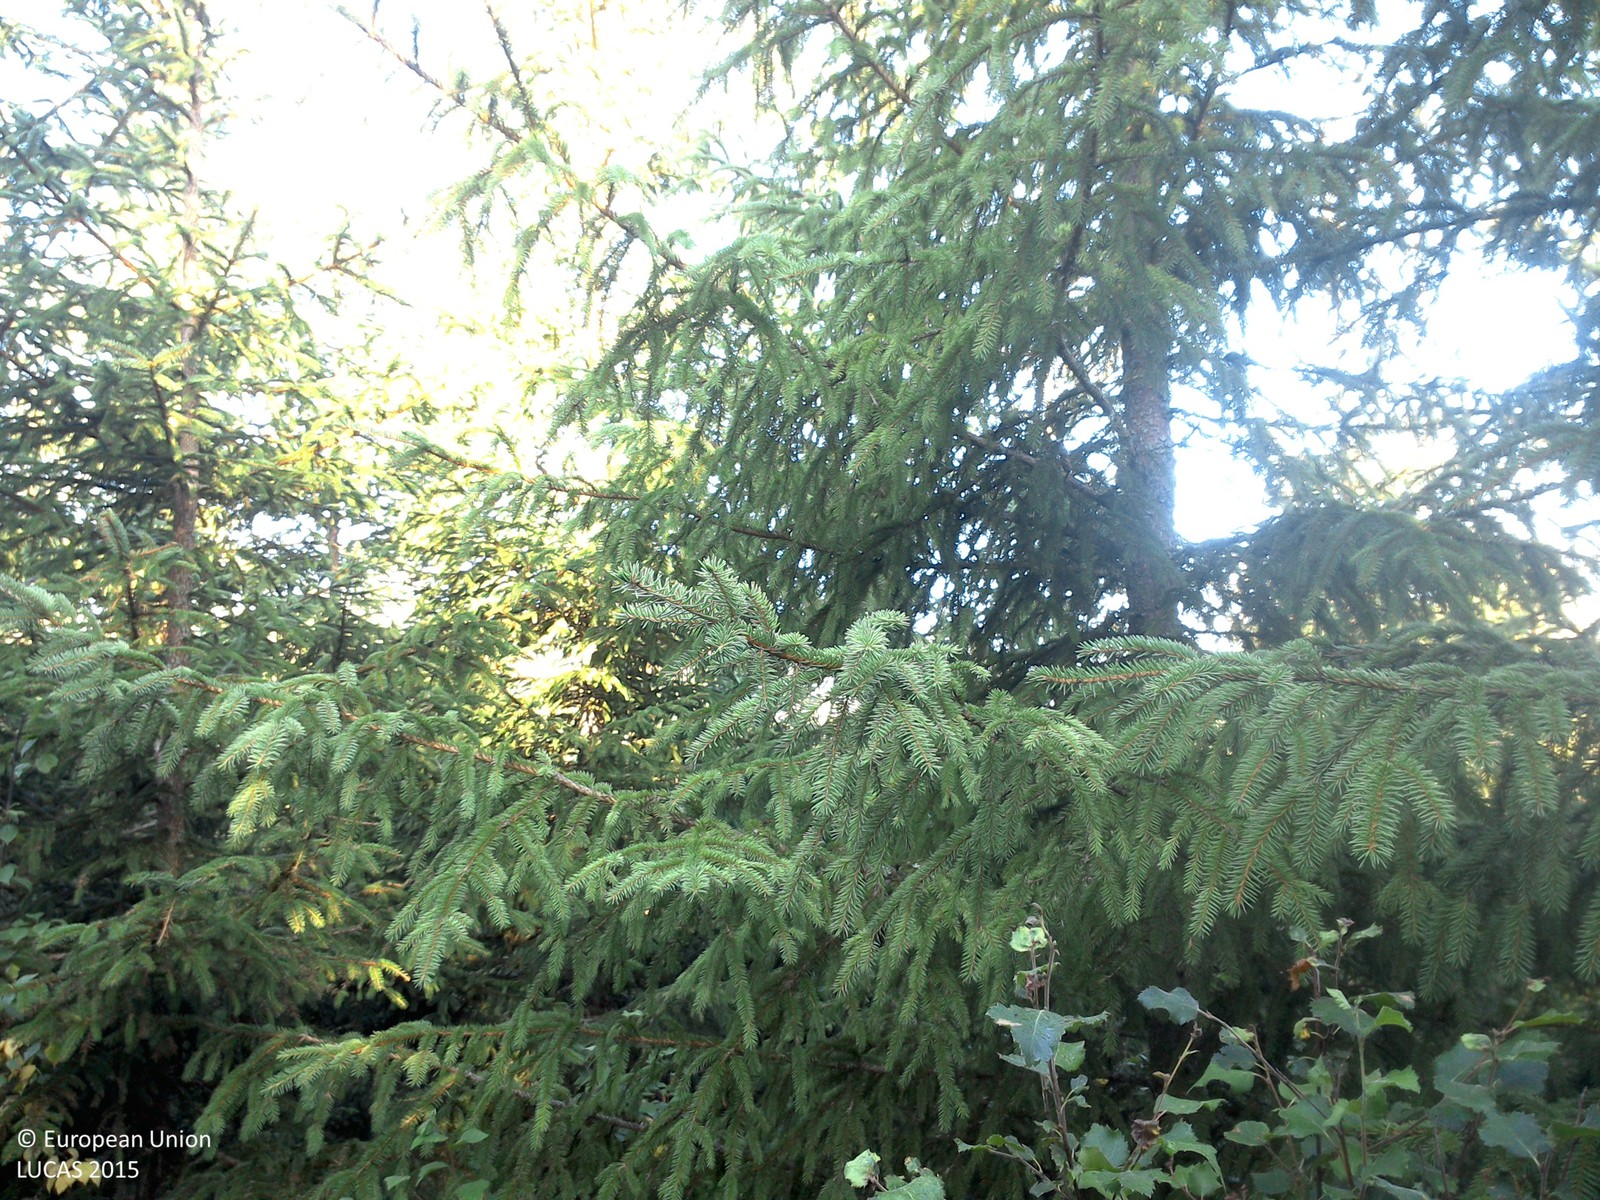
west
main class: Woodland
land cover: Spruce dominated coniferous woodland
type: boreal forest
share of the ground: > 75 %
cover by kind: coniferous forest trees 80 %, herbaceous plants 20 %
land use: Forestry
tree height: < 5 m
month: August
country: SE
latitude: 58.0788
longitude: 14.8272
